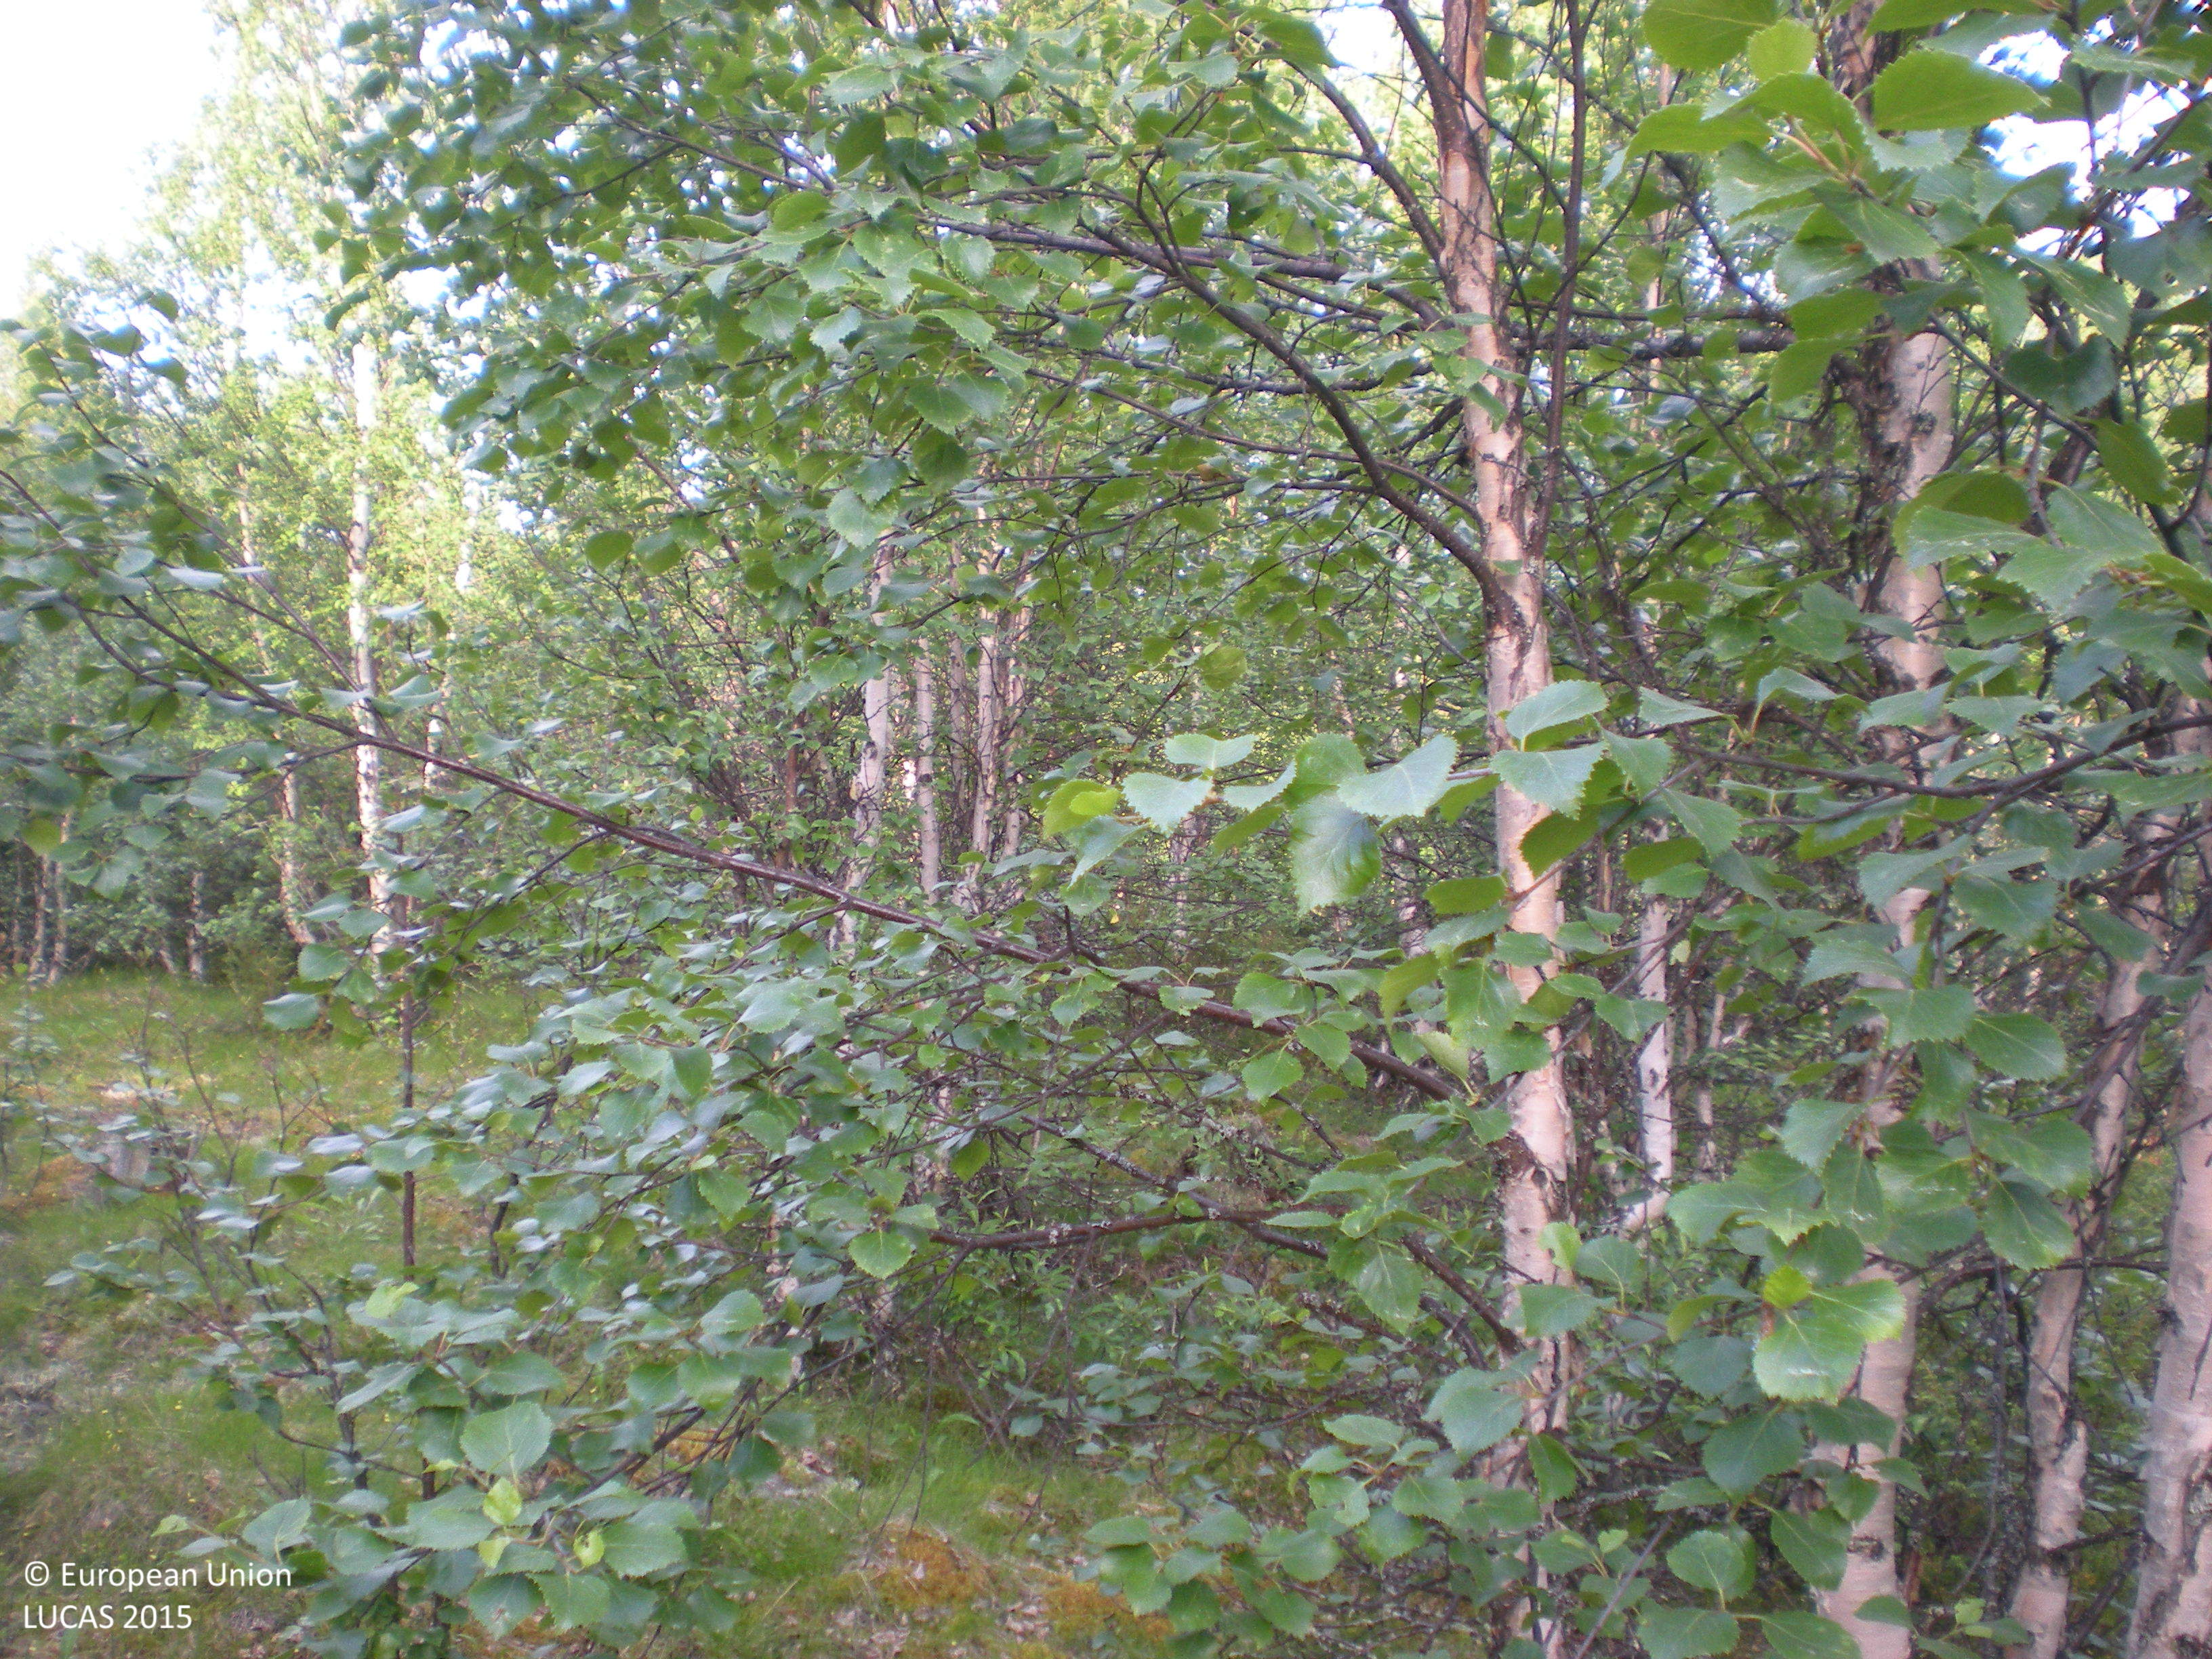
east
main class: Woodland
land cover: Broadleaved woodland
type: boreal forest
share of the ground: 50 - 75 %
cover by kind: broadleaved forest trees 70 %, lichens and mosses 15 %, herbaceous plants 10 %, shrubs 5 %
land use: Forestry
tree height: > 5 m
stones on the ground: > 50 %
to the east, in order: Broadleaved woodland; Pine dominated mixed woodland; Broadleaved woodland
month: July
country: SE
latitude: 65.6097
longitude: 17.7066
